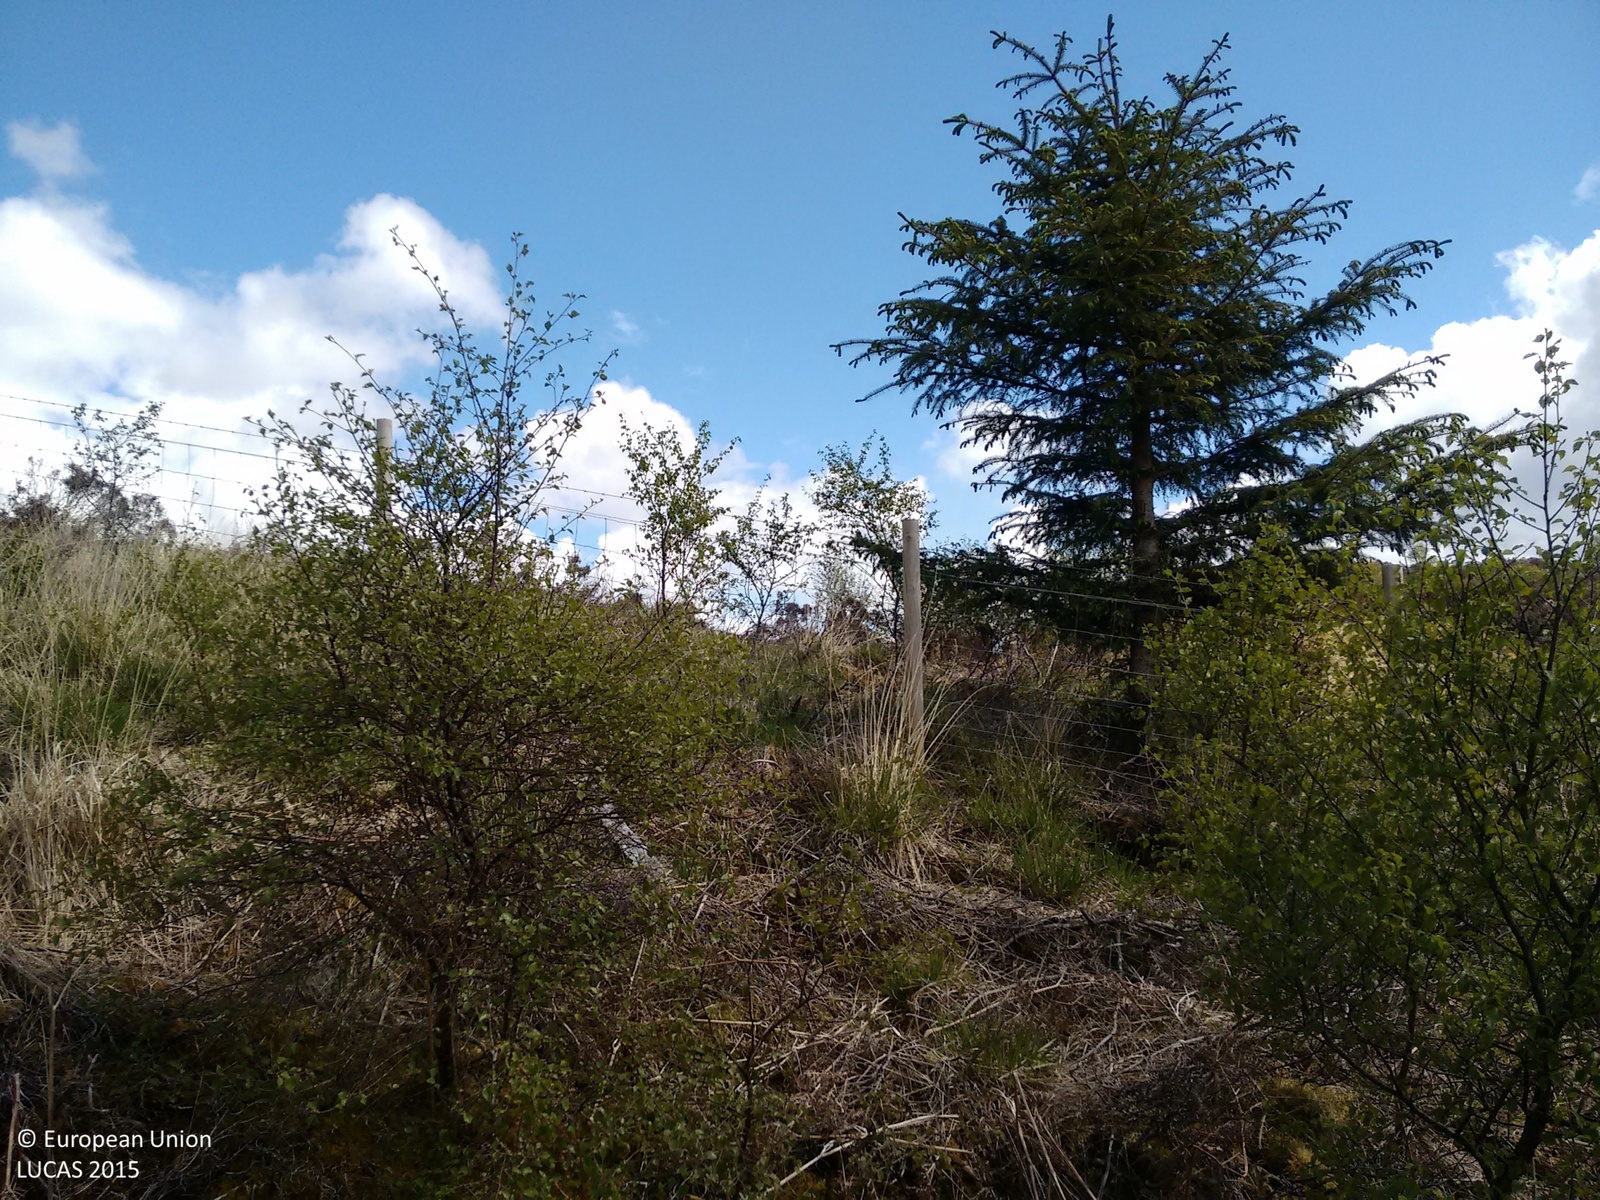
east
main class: Woodland
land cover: Broadleaved woodland
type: acidophilous oak and oak-birch forest
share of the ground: > 75 %
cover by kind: broadleaved forest trees 95 %, coniferous forest trees 5 %
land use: Semi-natural and natural areas not in use
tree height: > 5 m
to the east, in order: Broadleaved woodland; Rivers and streams; Broadleaved woodland; Other mixed woodland; Broadleaved woodland; Fences; Tracks; Grassland with sparse tree/shrub cover; Shrubland with sparse tree cover; Grassland without tree/shrub cover; Shrubland without tree cover; Single bushes/trees; Grassland without tree/shrub cover; Ditches and canals; Grassland without tree/shrub cover
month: May
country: GB
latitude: 55.9121
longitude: -5.2345
